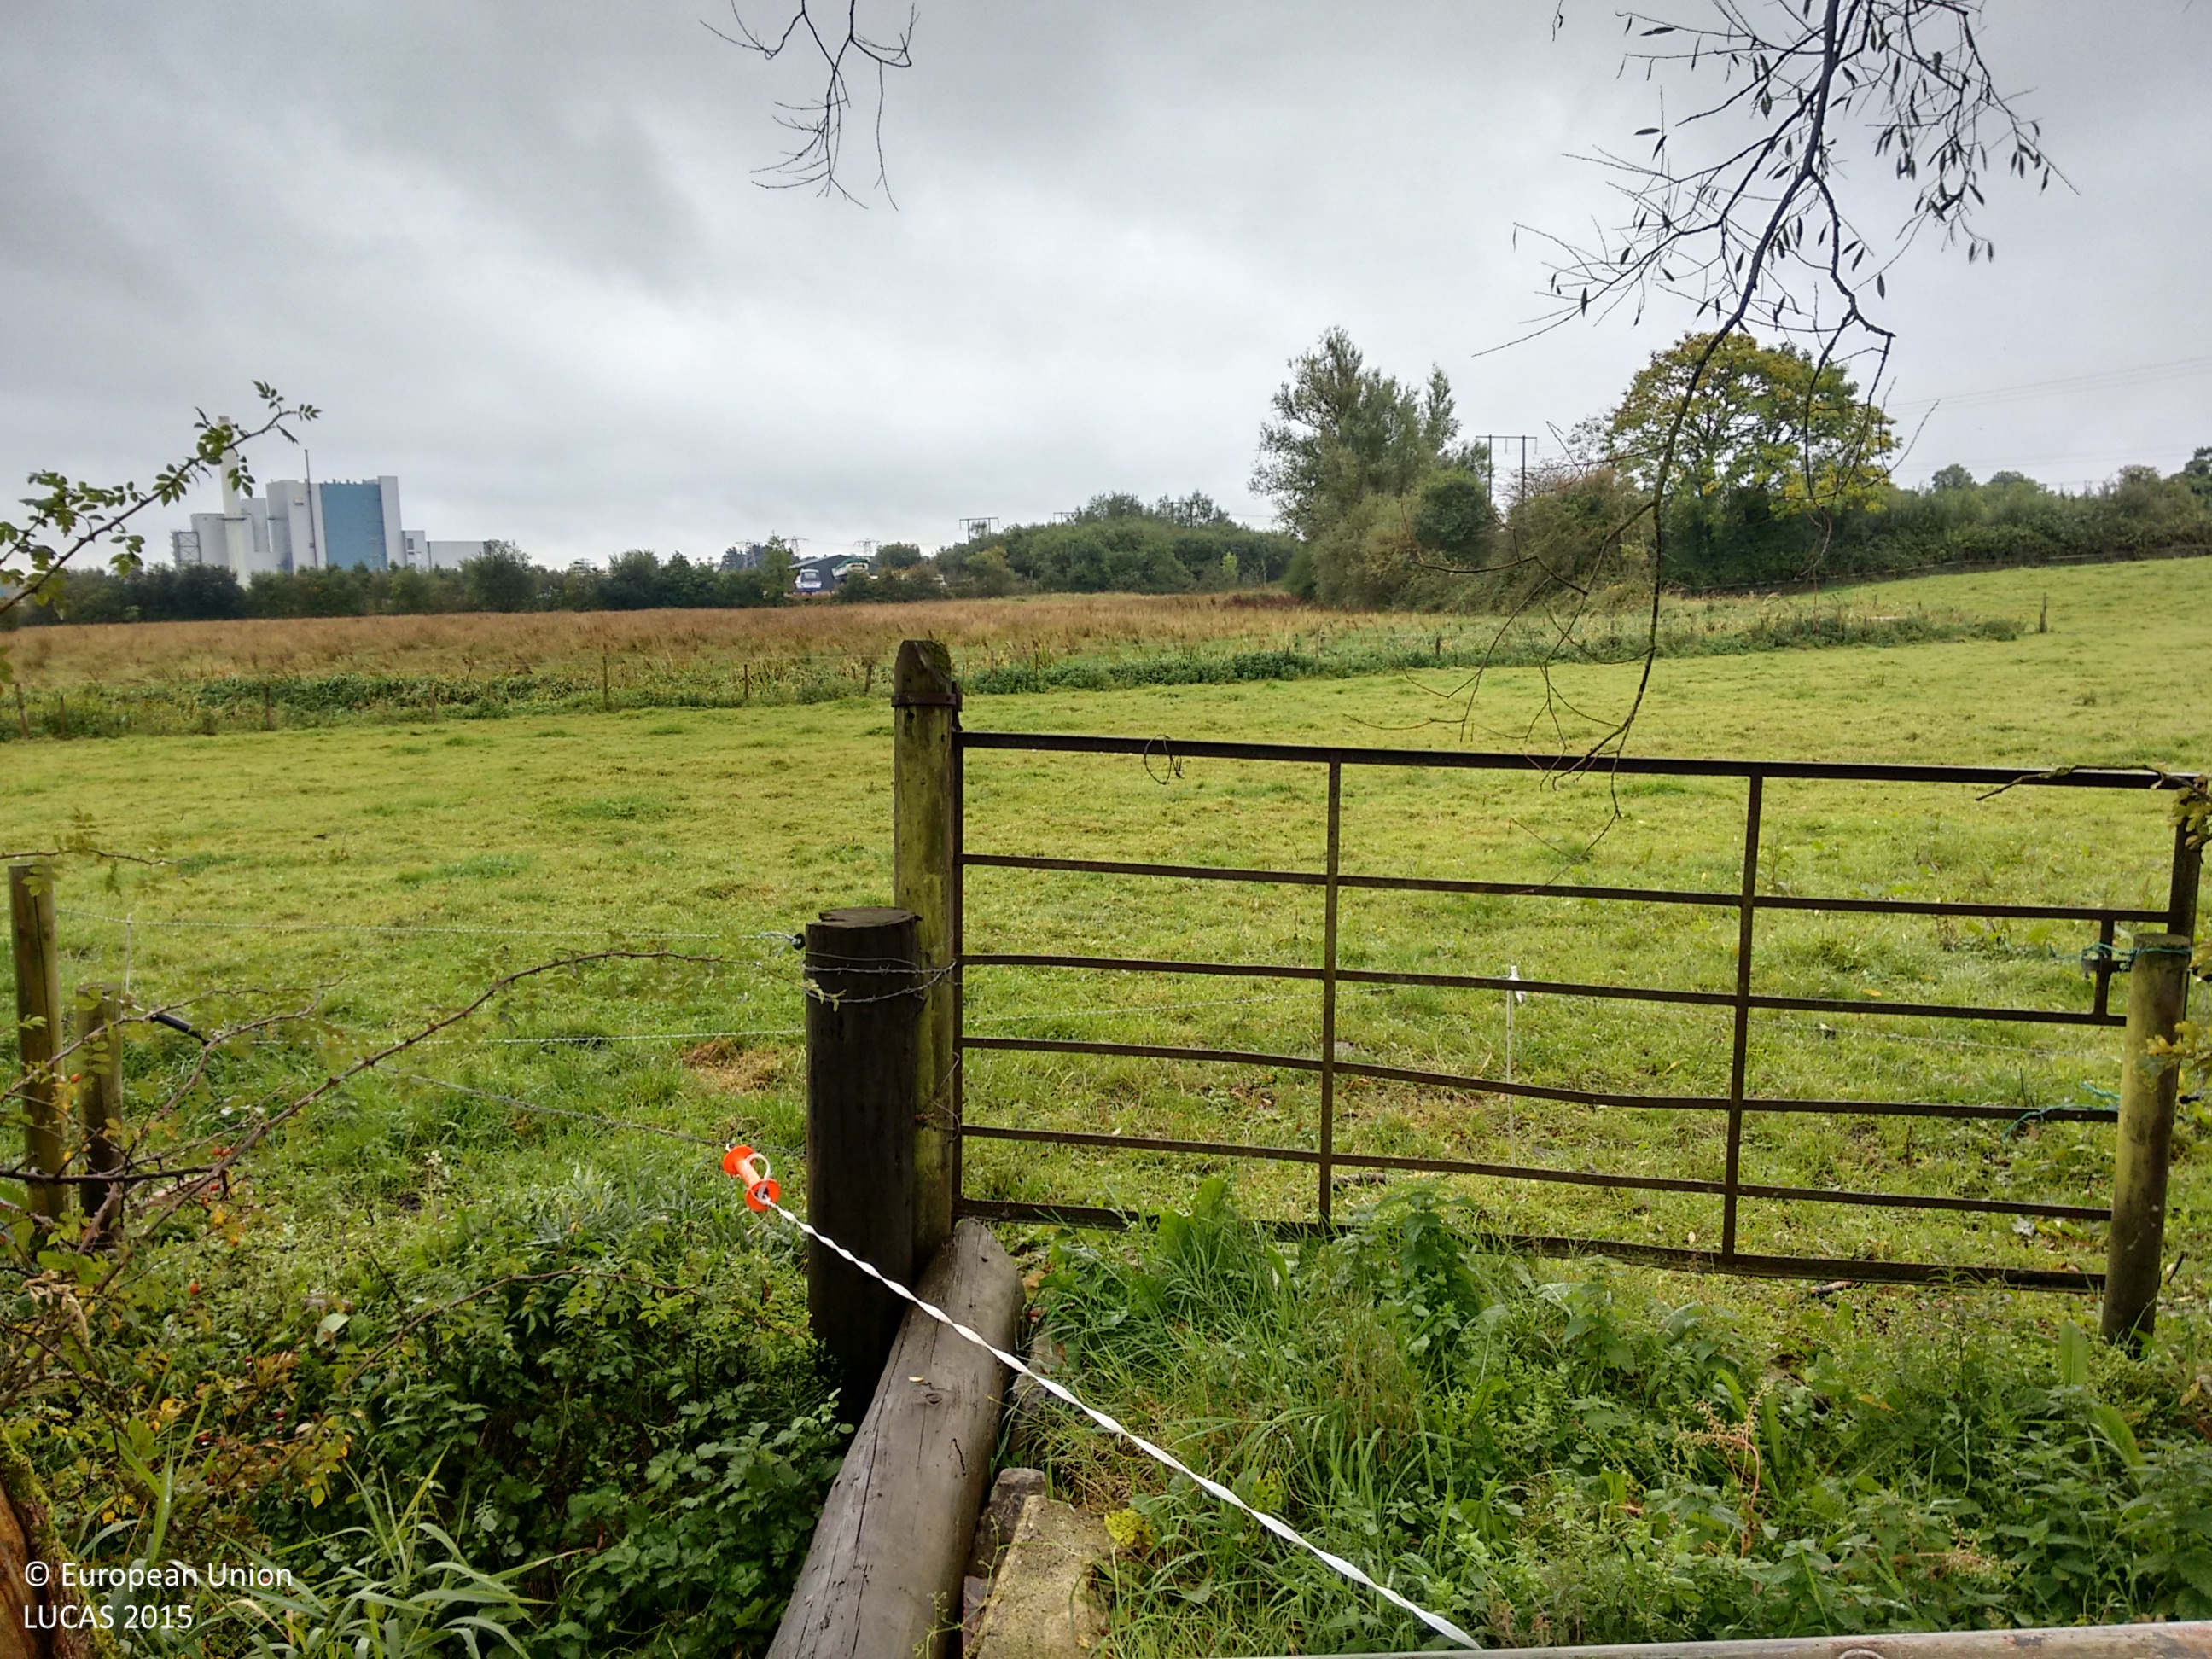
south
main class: Grassland
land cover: Grassland without tree/shrub cover
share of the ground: > 75 %
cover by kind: herbaceous plants 100 %
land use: Agriculture (excluding fallow land and kitchen gardens)
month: October
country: IE
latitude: 53.6799
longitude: -7.9940
